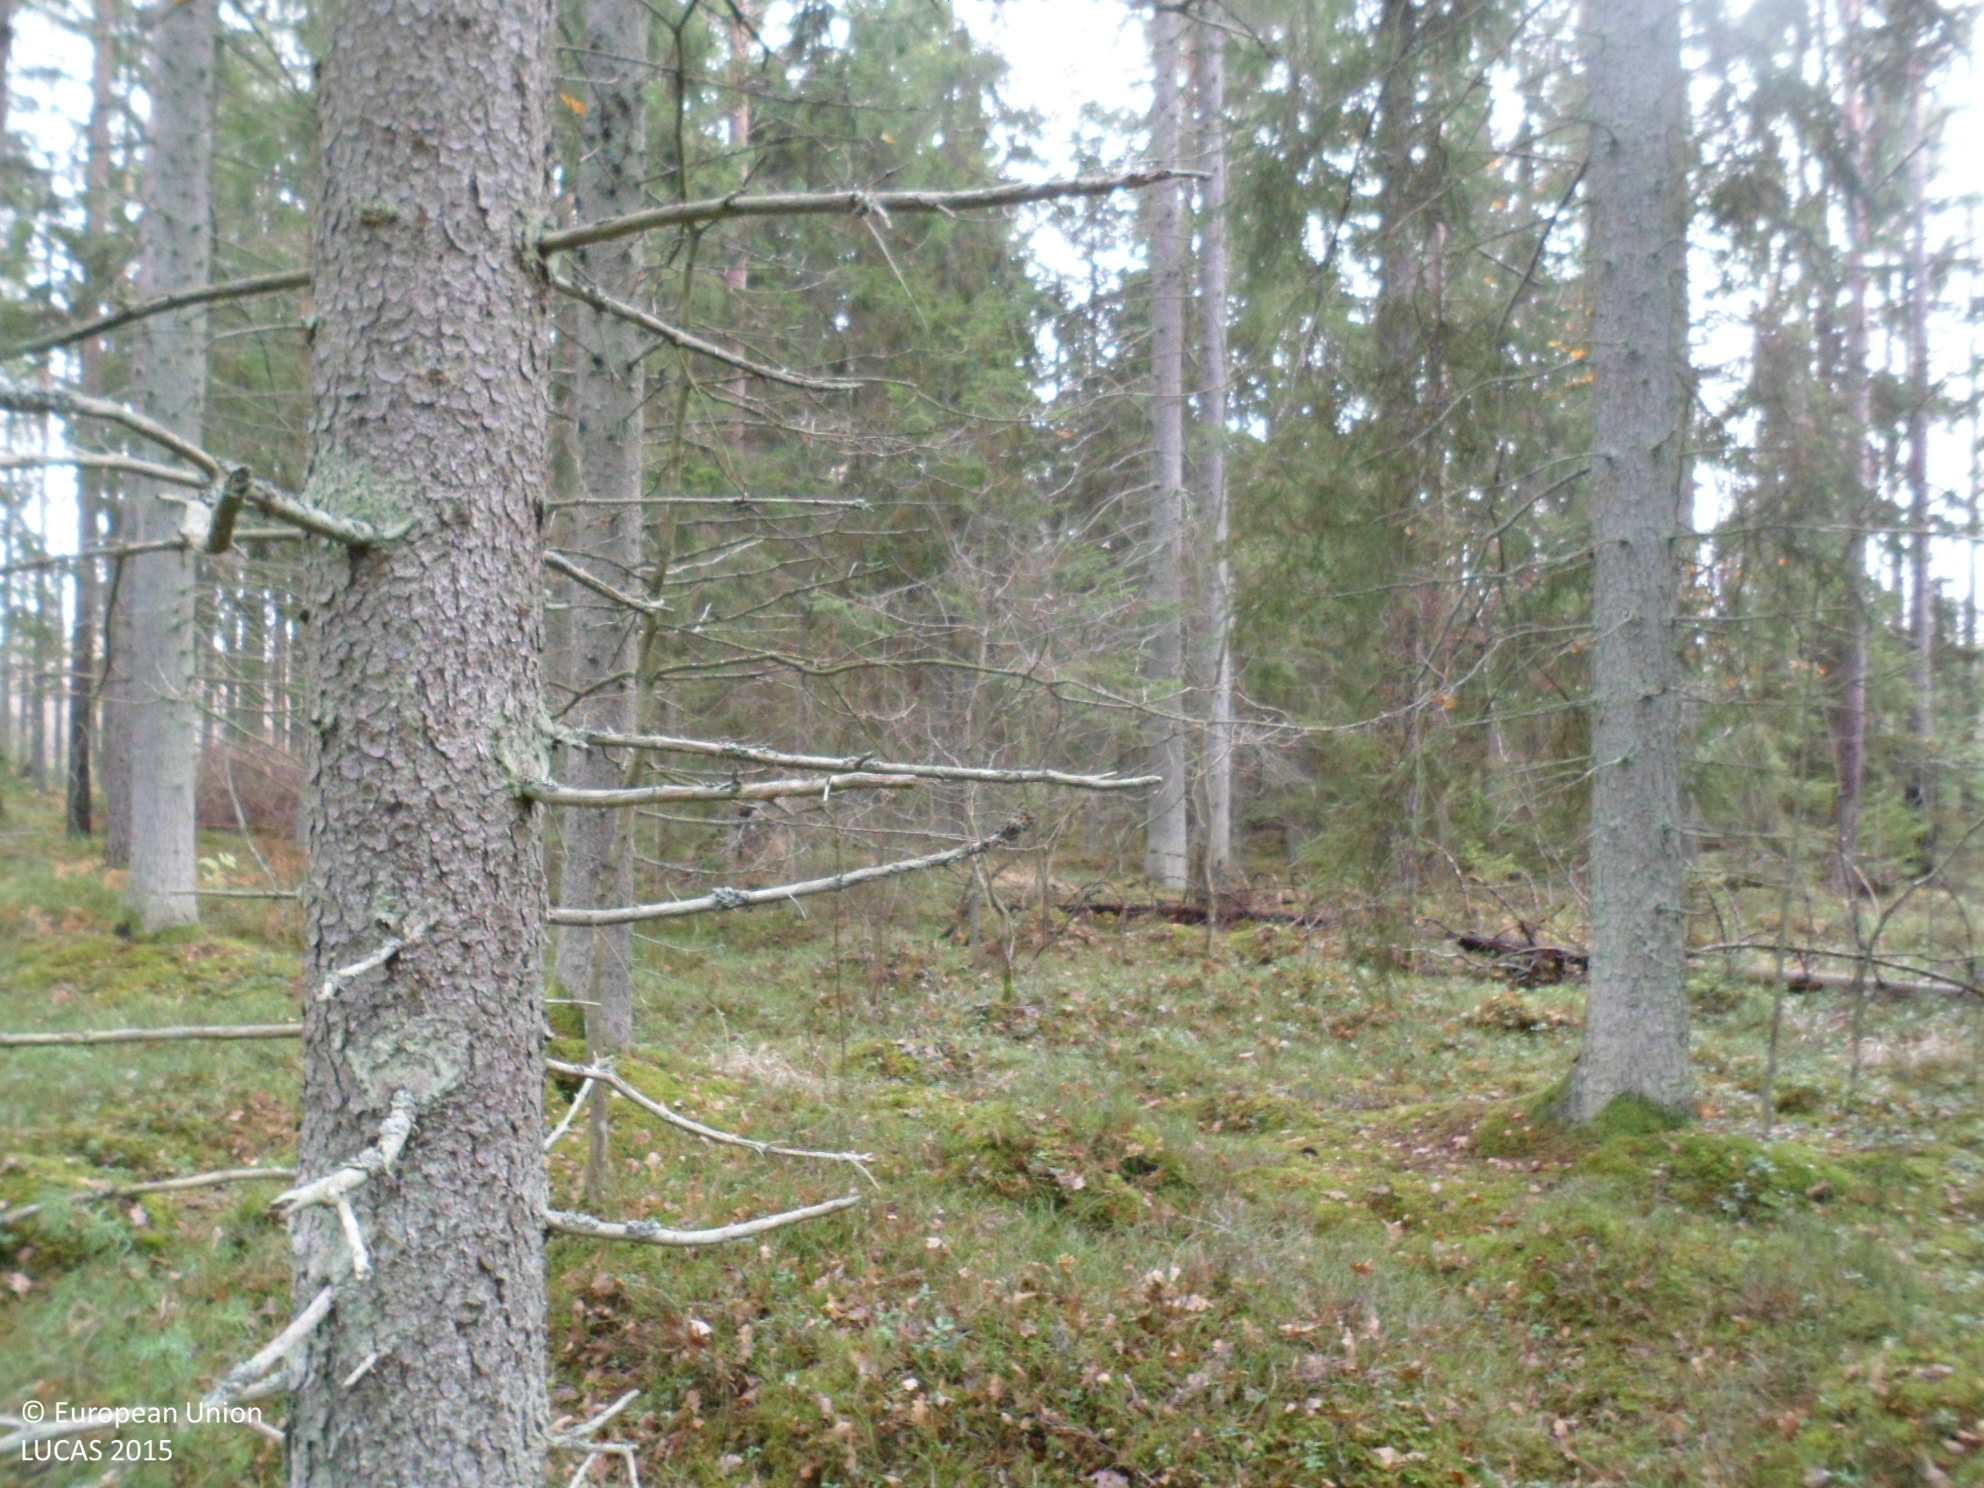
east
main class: Woodland
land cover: Spruce dominated coniferous woodland
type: boreal forest
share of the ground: 50 - 75 %
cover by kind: coniferous forest trees 60 %, lichens and mosses 20 %, shrubs 15 %, broadleaved forest trees 5 %
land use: Forestry
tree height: > 5 m
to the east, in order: Spruce dominated coniferous woodland; Pine dominated coniferous woodland; Pine dominated mixed woodland; Paved roads, cycling and walking lanes; Pine dominated mixed woodland; Paved roads, cycling and walking lanes; Grass margins; Tracks; Grassland with sparse tree/shrub cover; Pine dominated mixed woodland
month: November
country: SE
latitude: 56.7566
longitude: 15.8711
